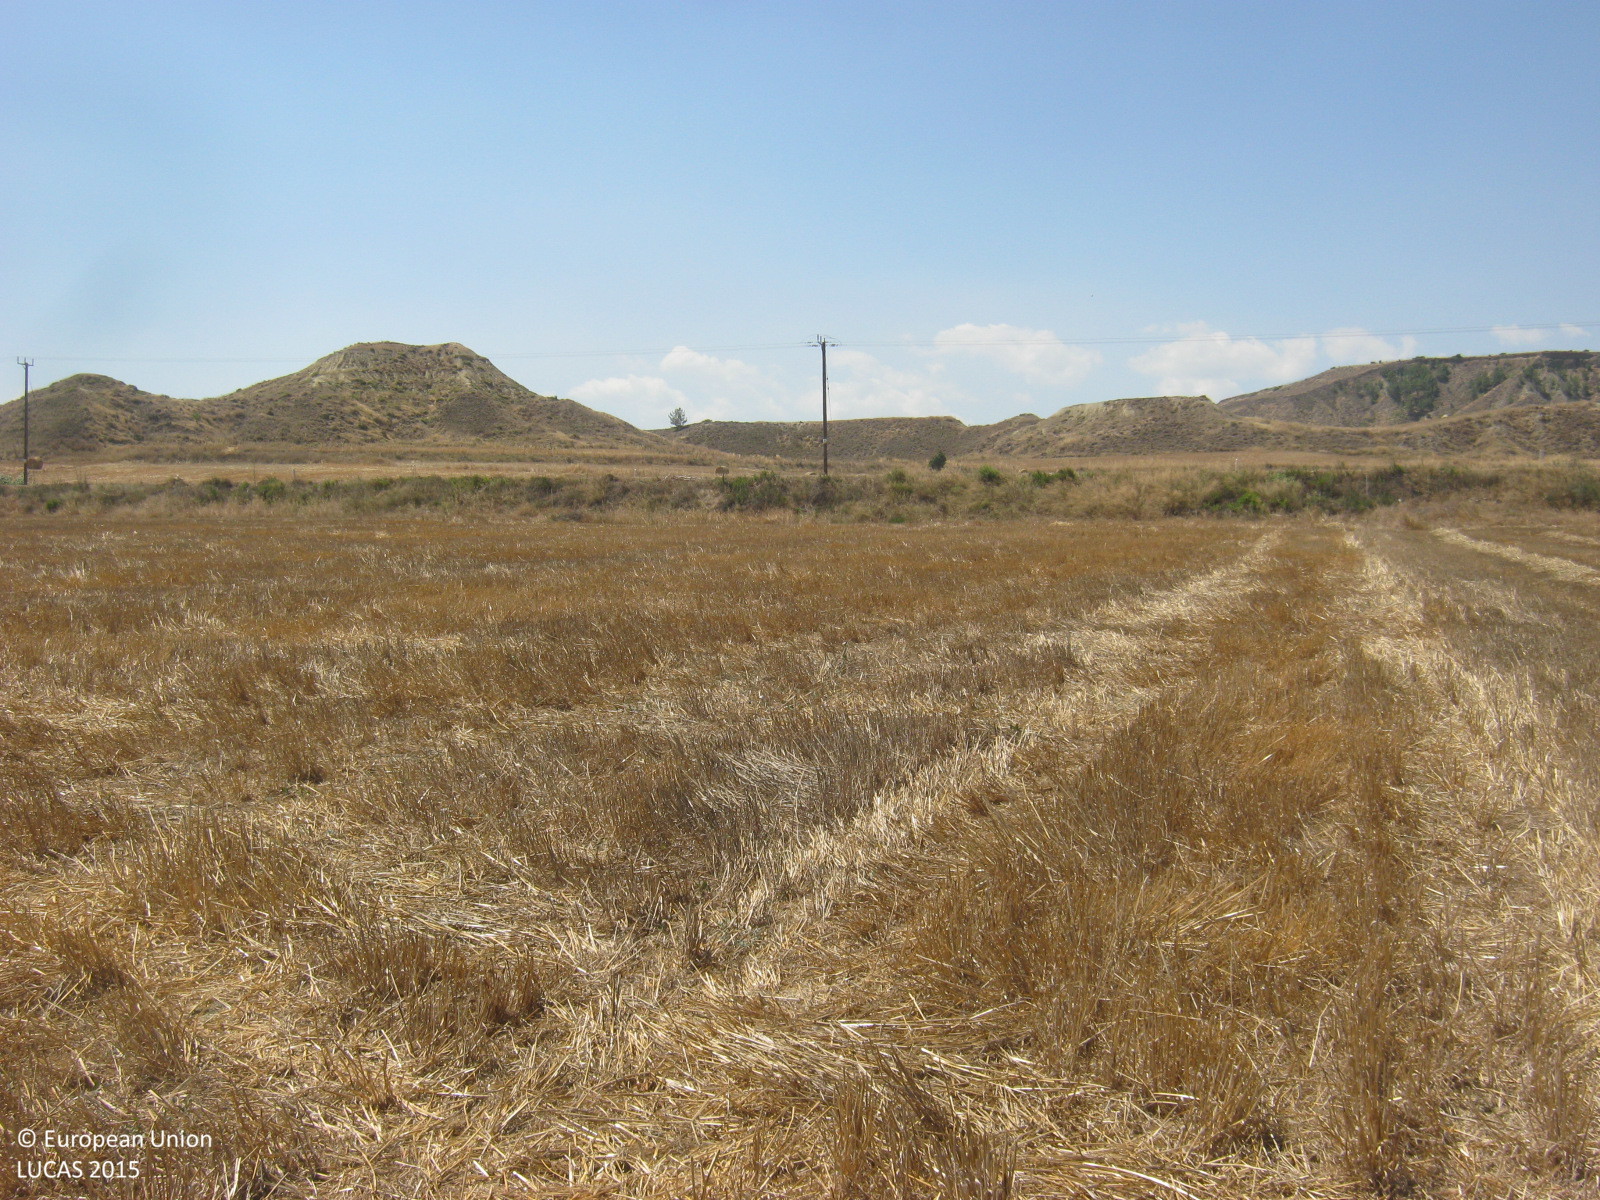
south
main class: Cropland
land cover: Barley
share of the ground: < 10 %
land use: Agriculture (excluding fallow land and kitchen gardens)
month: June
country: CY
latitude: 35.0725
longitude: 33.1572
